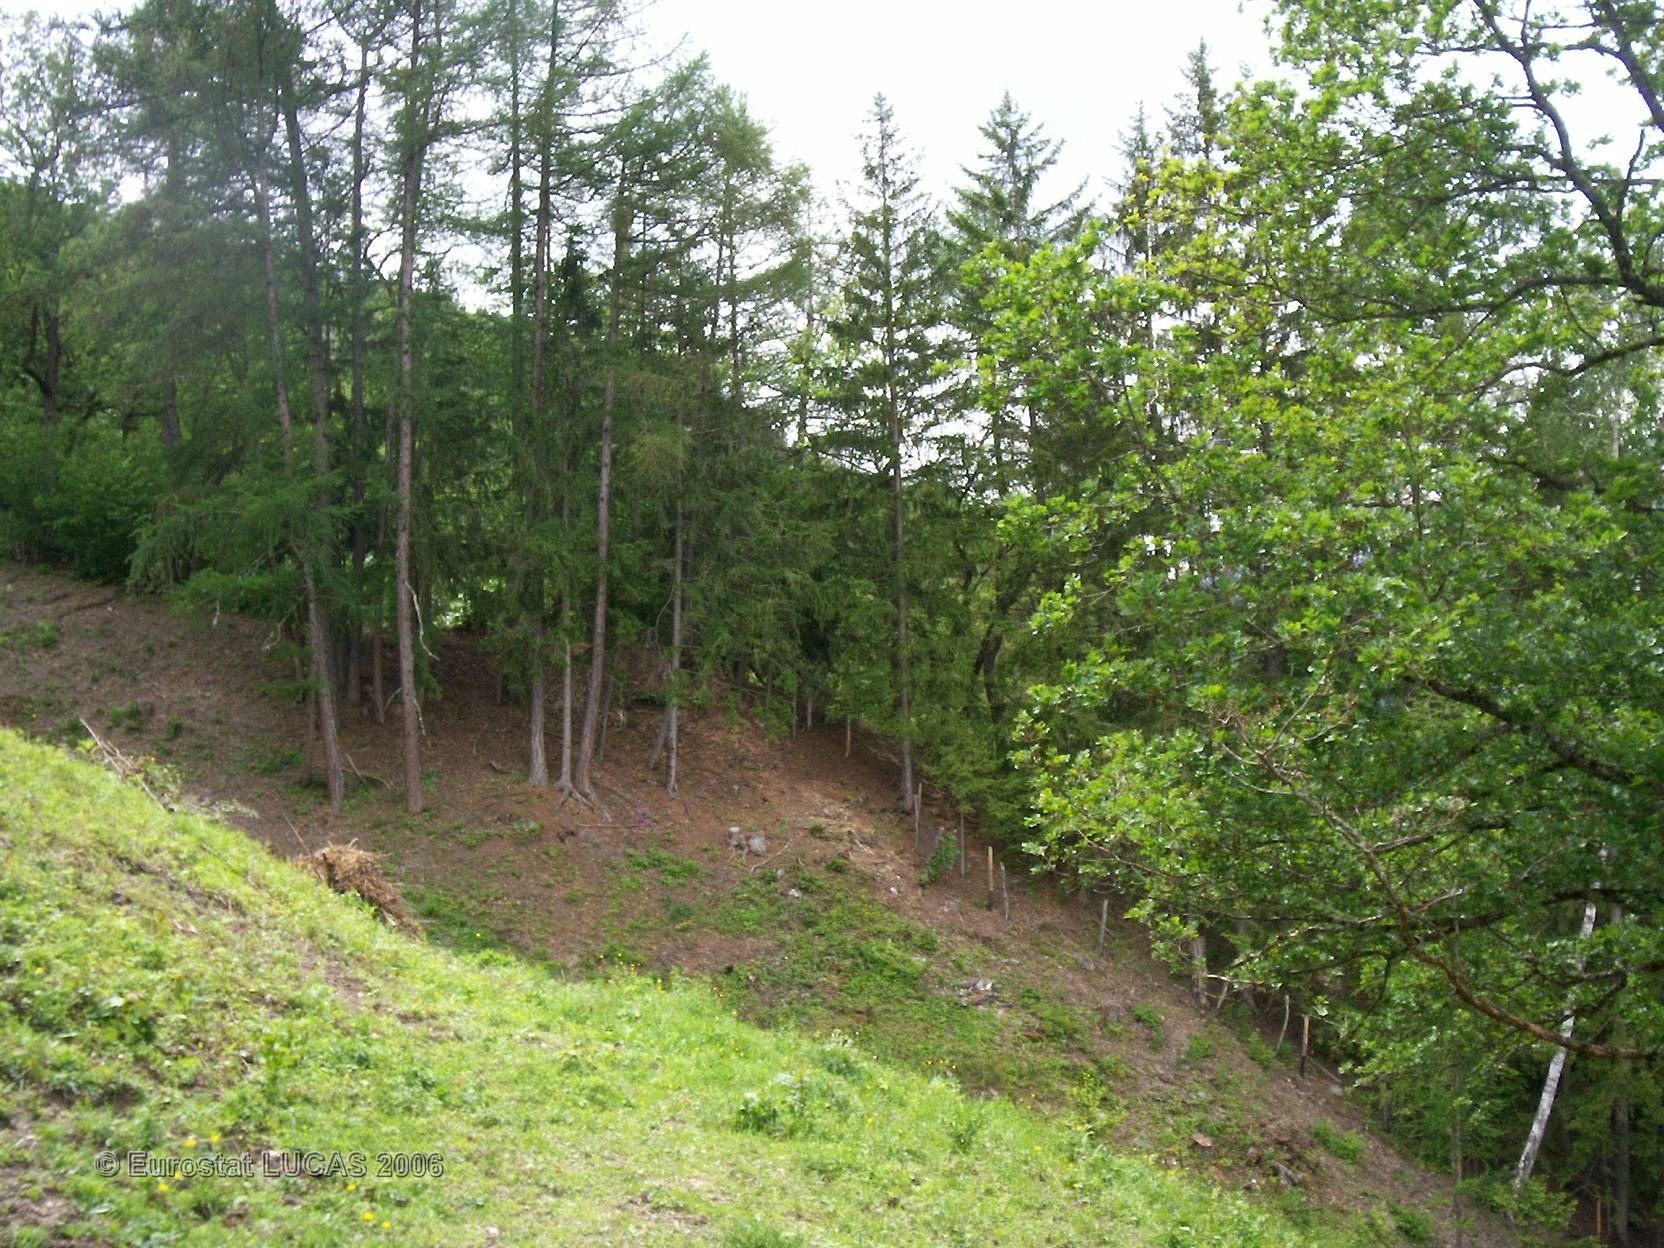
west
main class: Grassland
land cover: Grassland with sparse tree/shrub cover
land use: Agriculture (excluding fallow land and kitchen gardens)
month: May
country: FR
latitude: 45.5614
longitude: 6.7118
